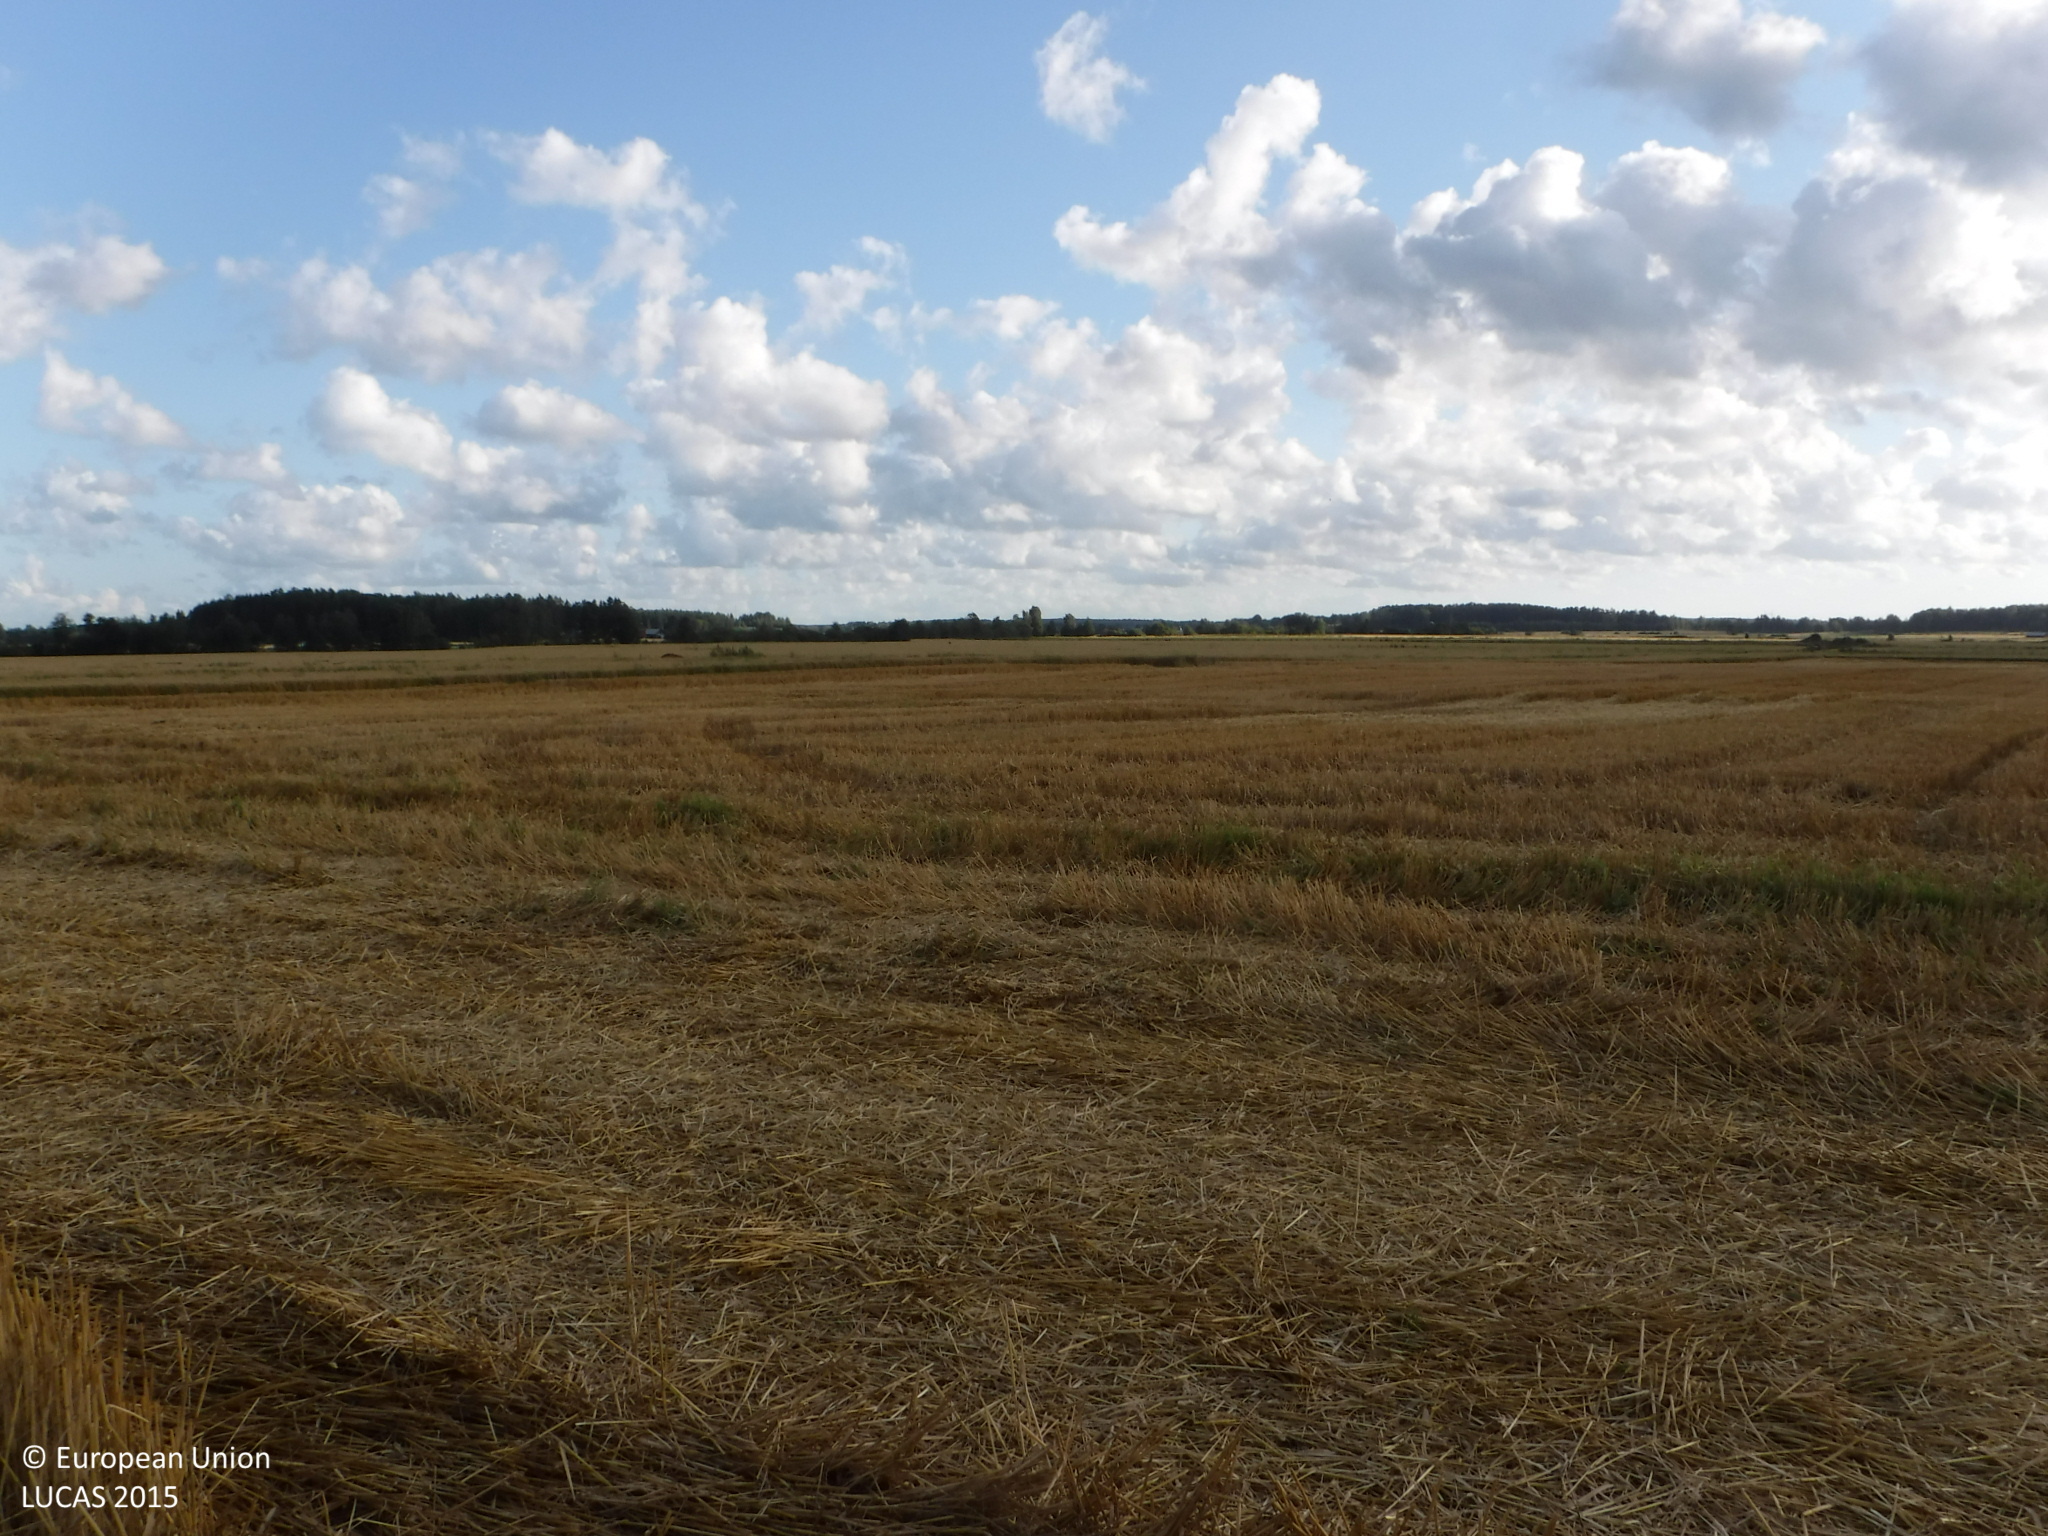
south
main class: Cropland
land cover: Rye
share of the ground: > 75 %
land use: Agriculture (excluding fallow land and kitchen gardens)
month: August
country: FI
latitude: 61.2471
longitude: 22.0794
